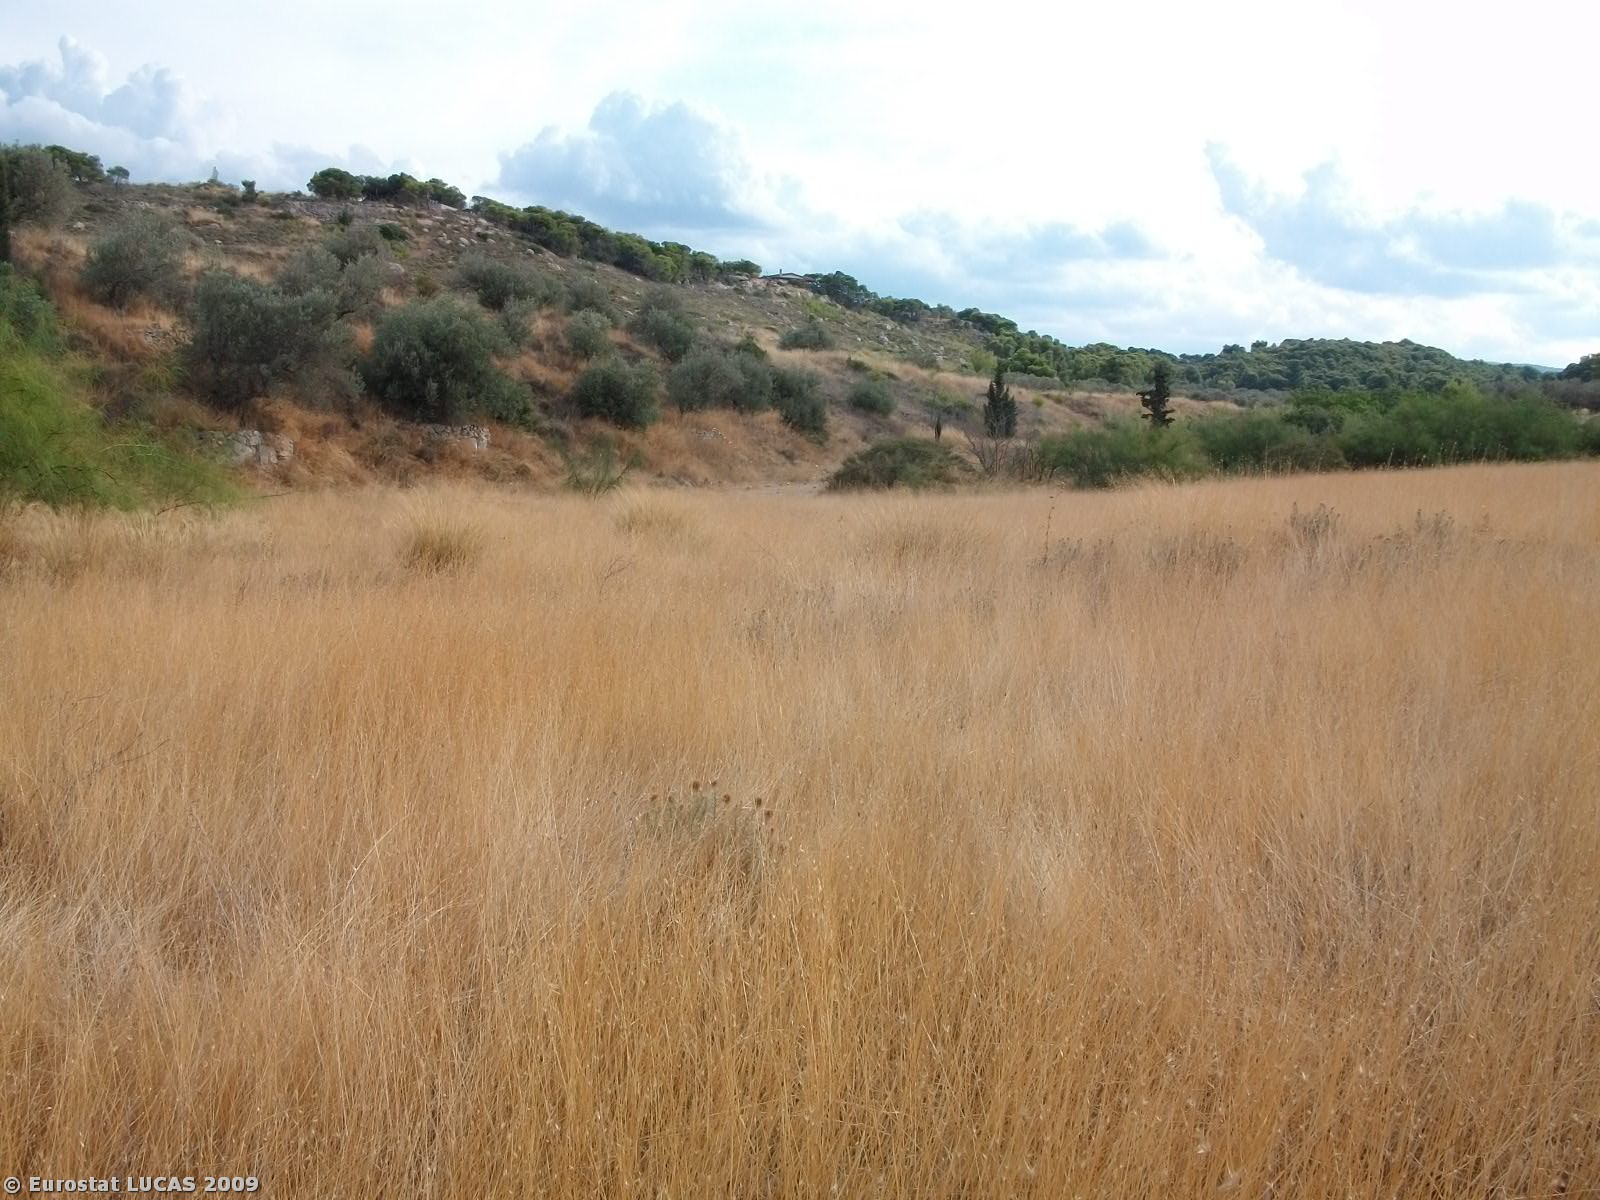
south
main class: Grassland
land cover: Spontaneously vegetated surfaces
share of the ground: > 75 %
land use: Fallow land
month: September
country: GR
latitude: 37.9152
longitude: 22.9966
